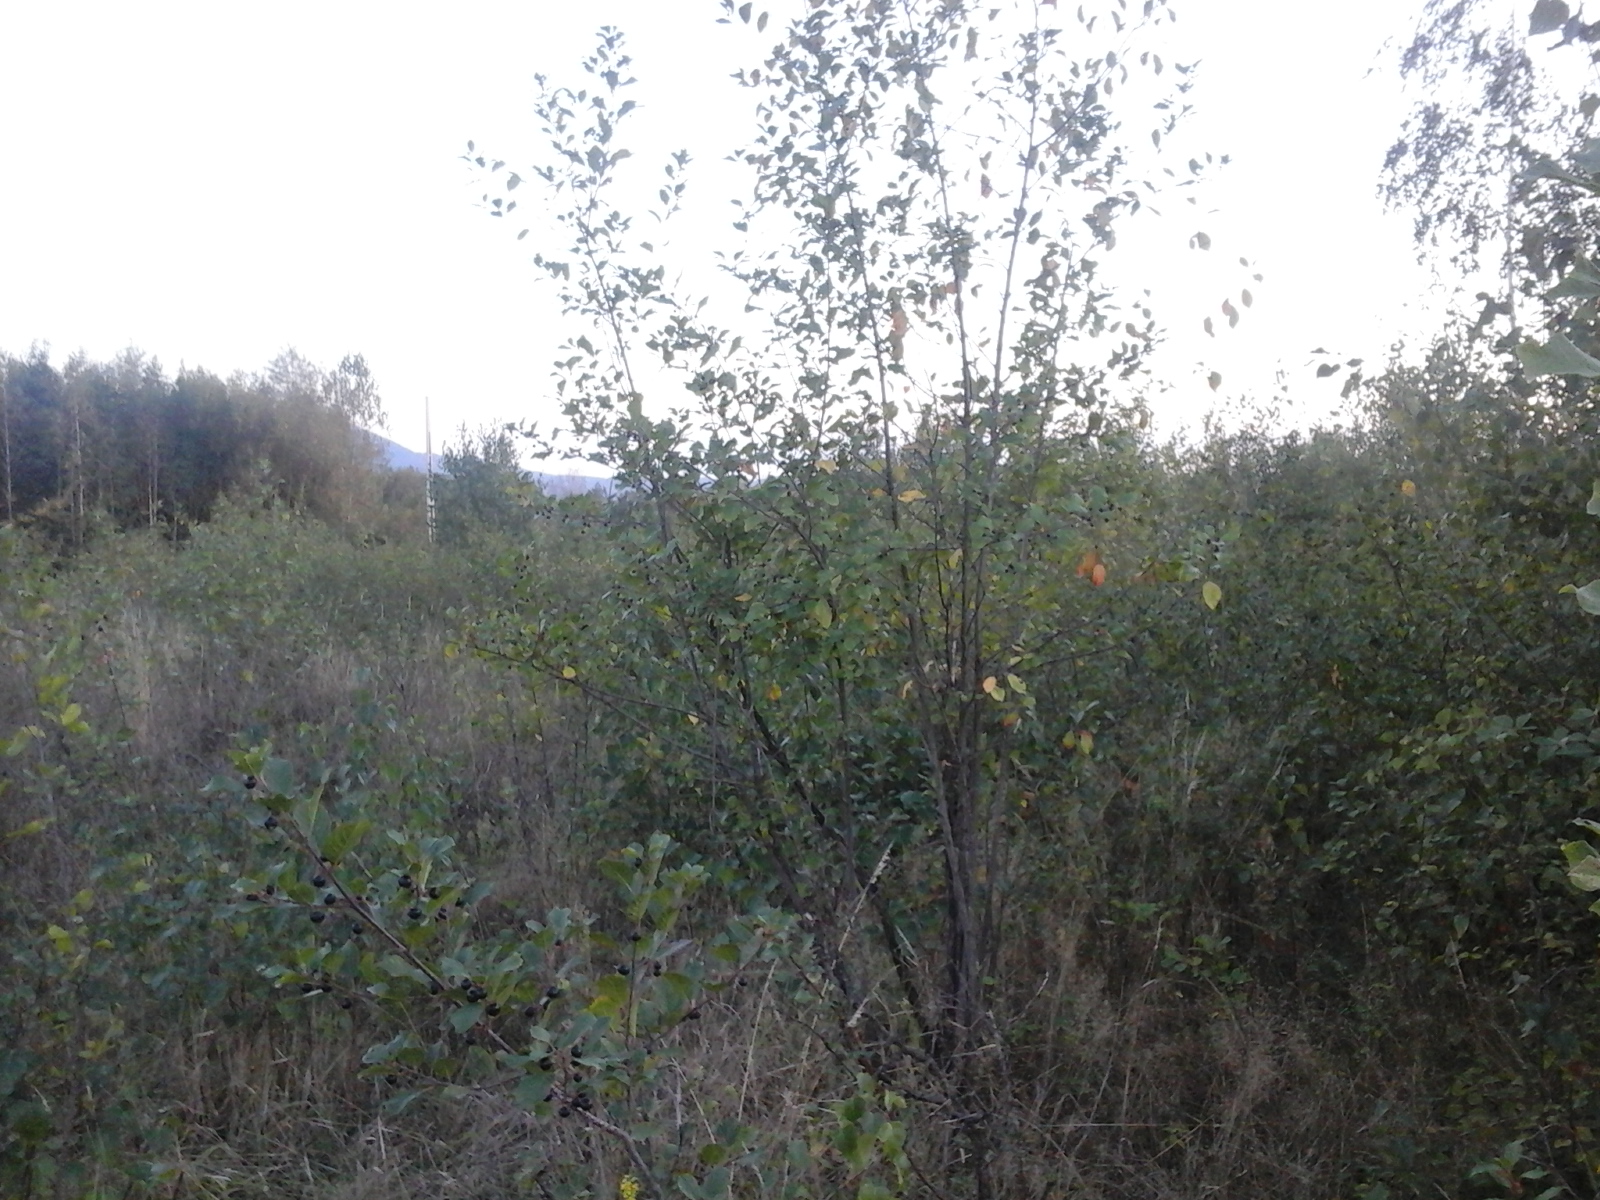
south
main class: Shrubland
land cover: Shrubland with sparse tree cover
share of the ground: > 75 %
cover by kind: shrubs 95 %, broadleaved forest trees 5 %
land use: Semi-natural and natural areas not in use
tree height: > 5 m
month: September
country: RO
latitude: 47.9066
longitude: 23.4402
